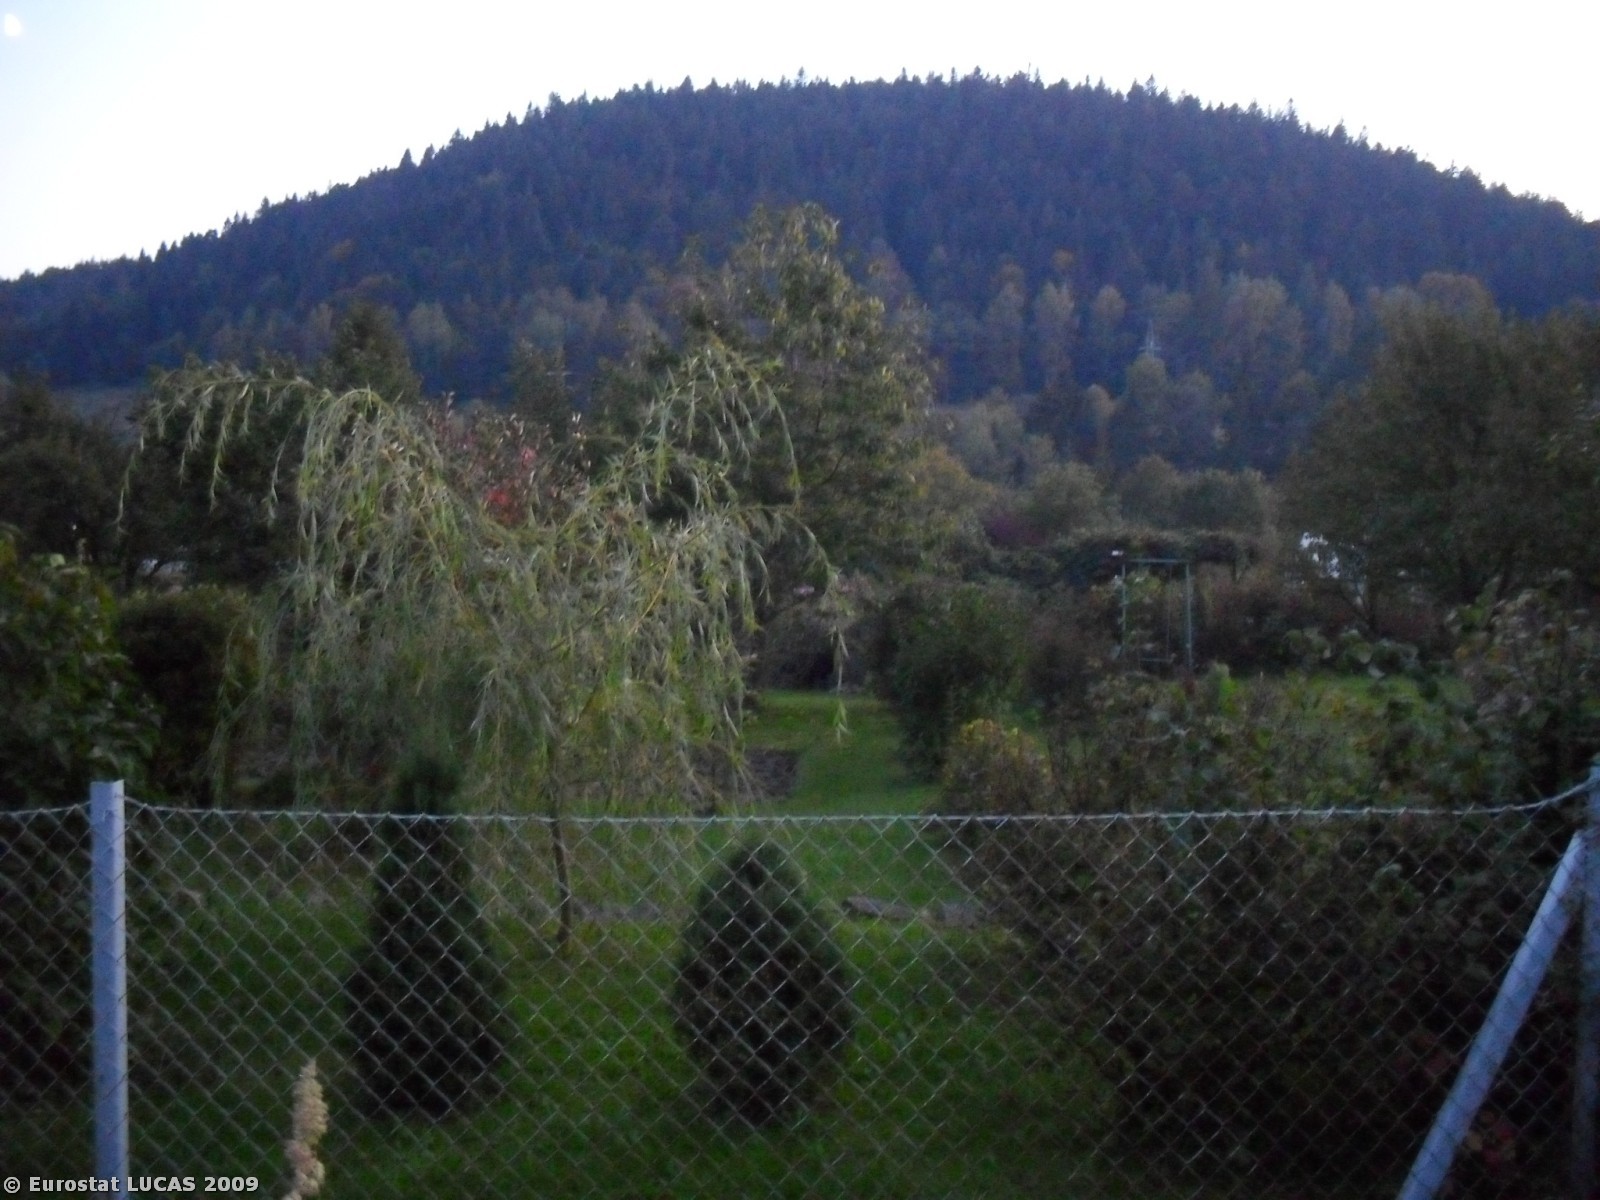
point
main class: Grassland
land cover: Grassland with sparse tree/shrub cover
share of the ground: > 75 %
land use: Residential
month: September
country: PL
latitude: 49.4017
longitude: 20.9423
